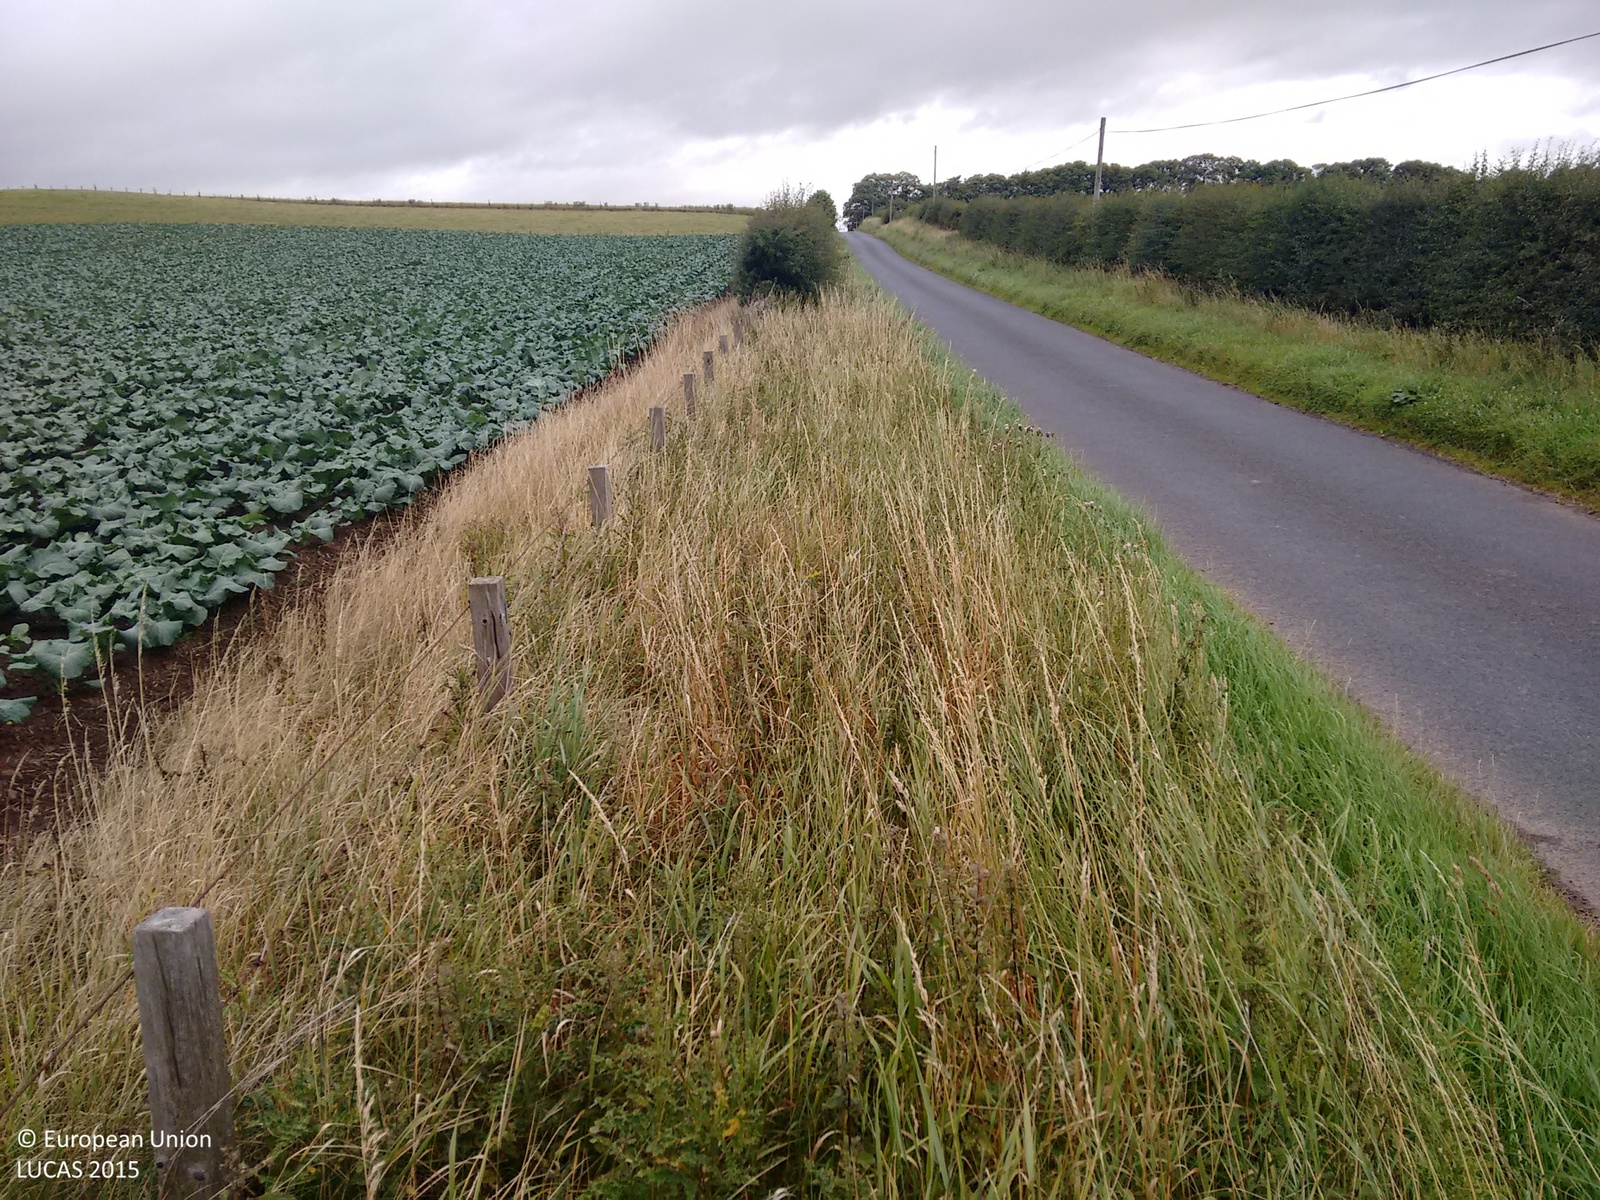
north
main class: Cropland
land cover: Other fresh vegetables
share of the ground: > 75 %
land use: Agriculture (excluding fallow land and kitchen gardens)
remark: Tilled/Sowed
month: August
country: GB
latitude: 55.5287
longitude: -2.4004
